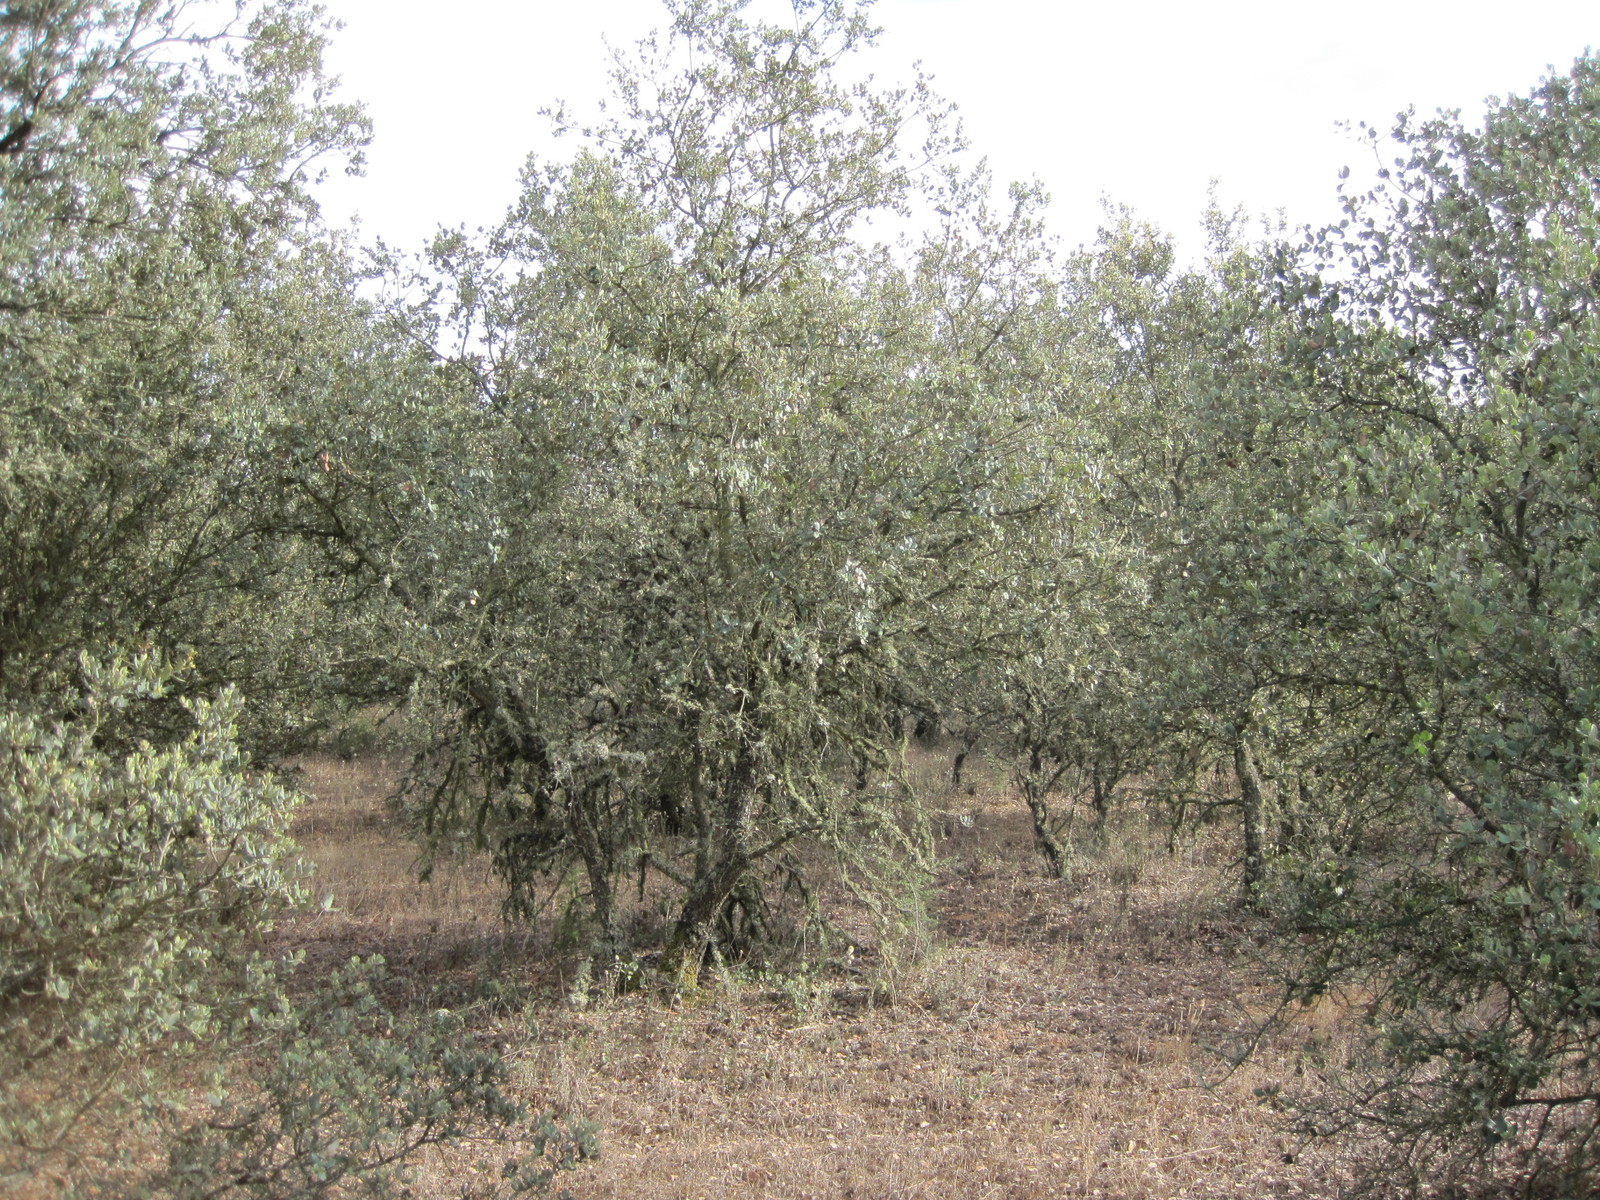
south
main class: Woodland
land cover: Broadleaved woodland
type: broadleaved evergreen forest
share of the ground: 50 - 75 %
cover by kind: broadleaved forest trees 70 %, herbaceous plants 30 %
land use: Forestry
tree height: > 5 m
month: July
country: ES
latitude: 41.9270
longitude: -5.6340
